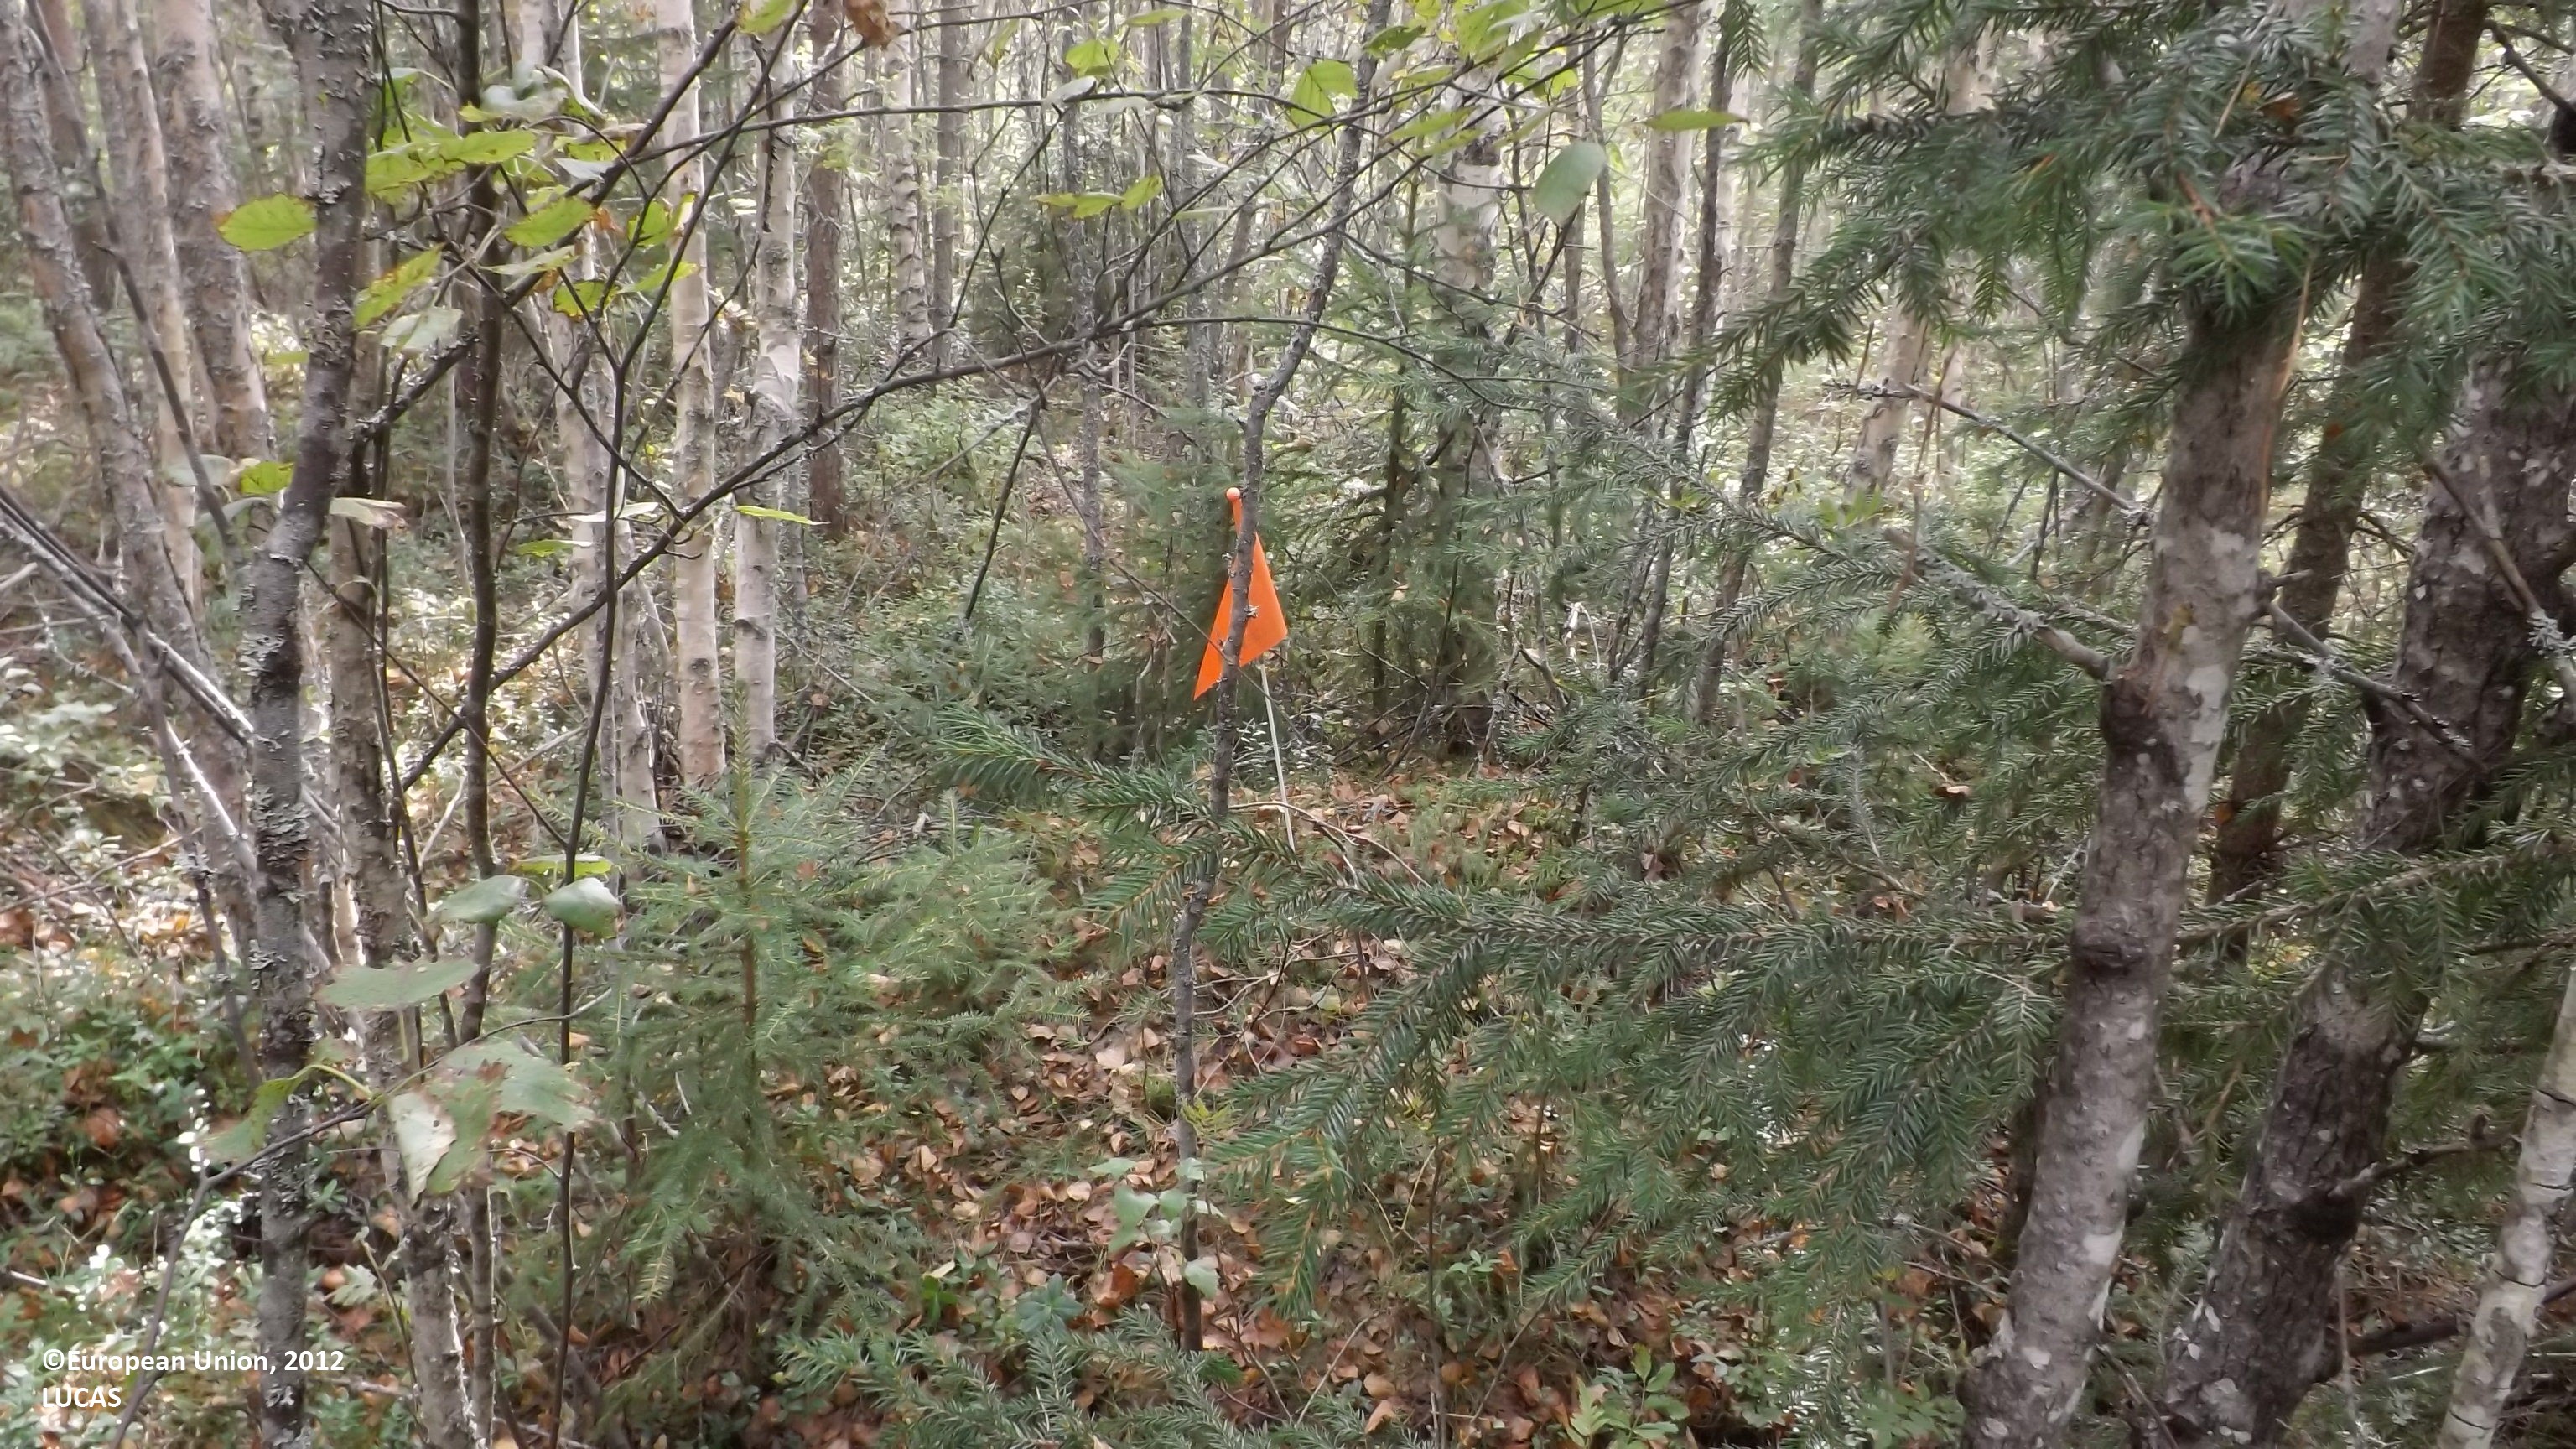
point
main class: Woodland
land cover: Other mixed woodland
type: boreal forest
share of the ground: > 75 %
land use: Forestry
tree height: > 5 m
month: August
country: FI
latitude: 63.9179
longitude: 24.0313
